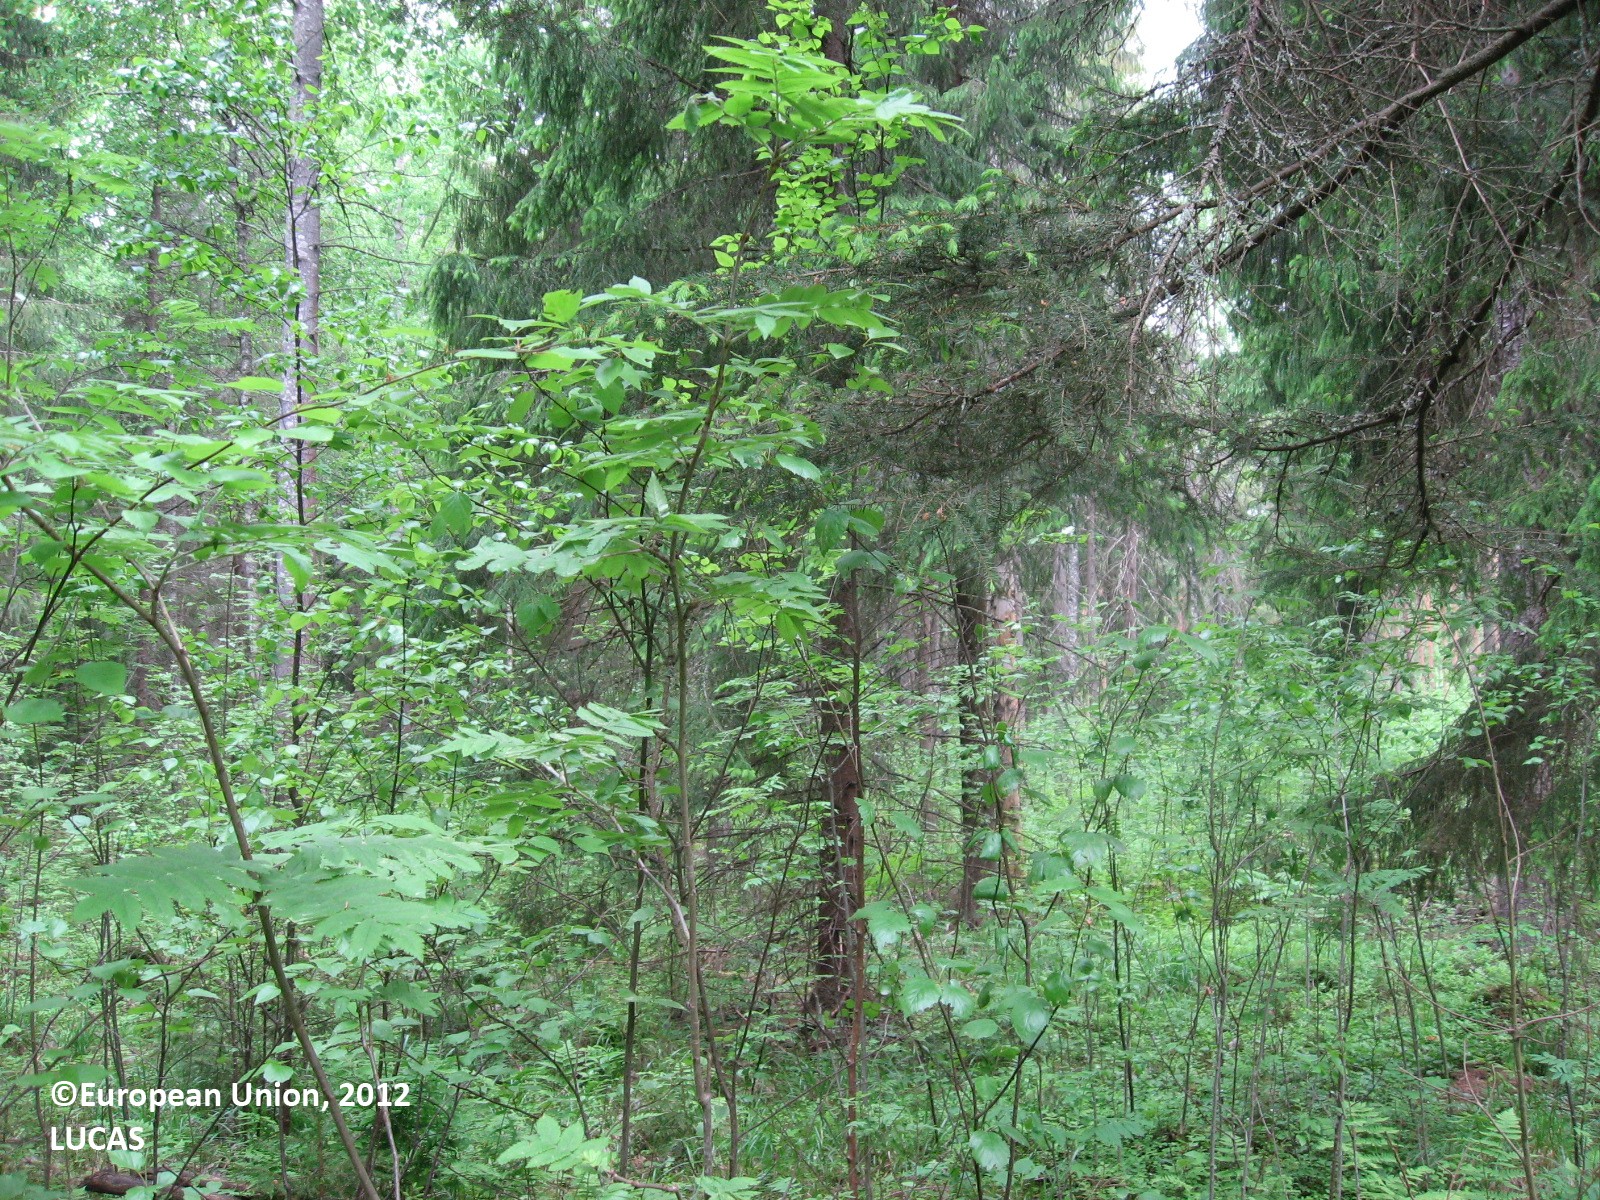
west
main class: Woodland
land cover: Spruce dominated mixed woodland
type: boreal forest
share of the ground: > 75 %
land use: Forestry
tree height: > 5 m
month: June
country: FI
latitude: 60.4415
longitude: 24.9642
